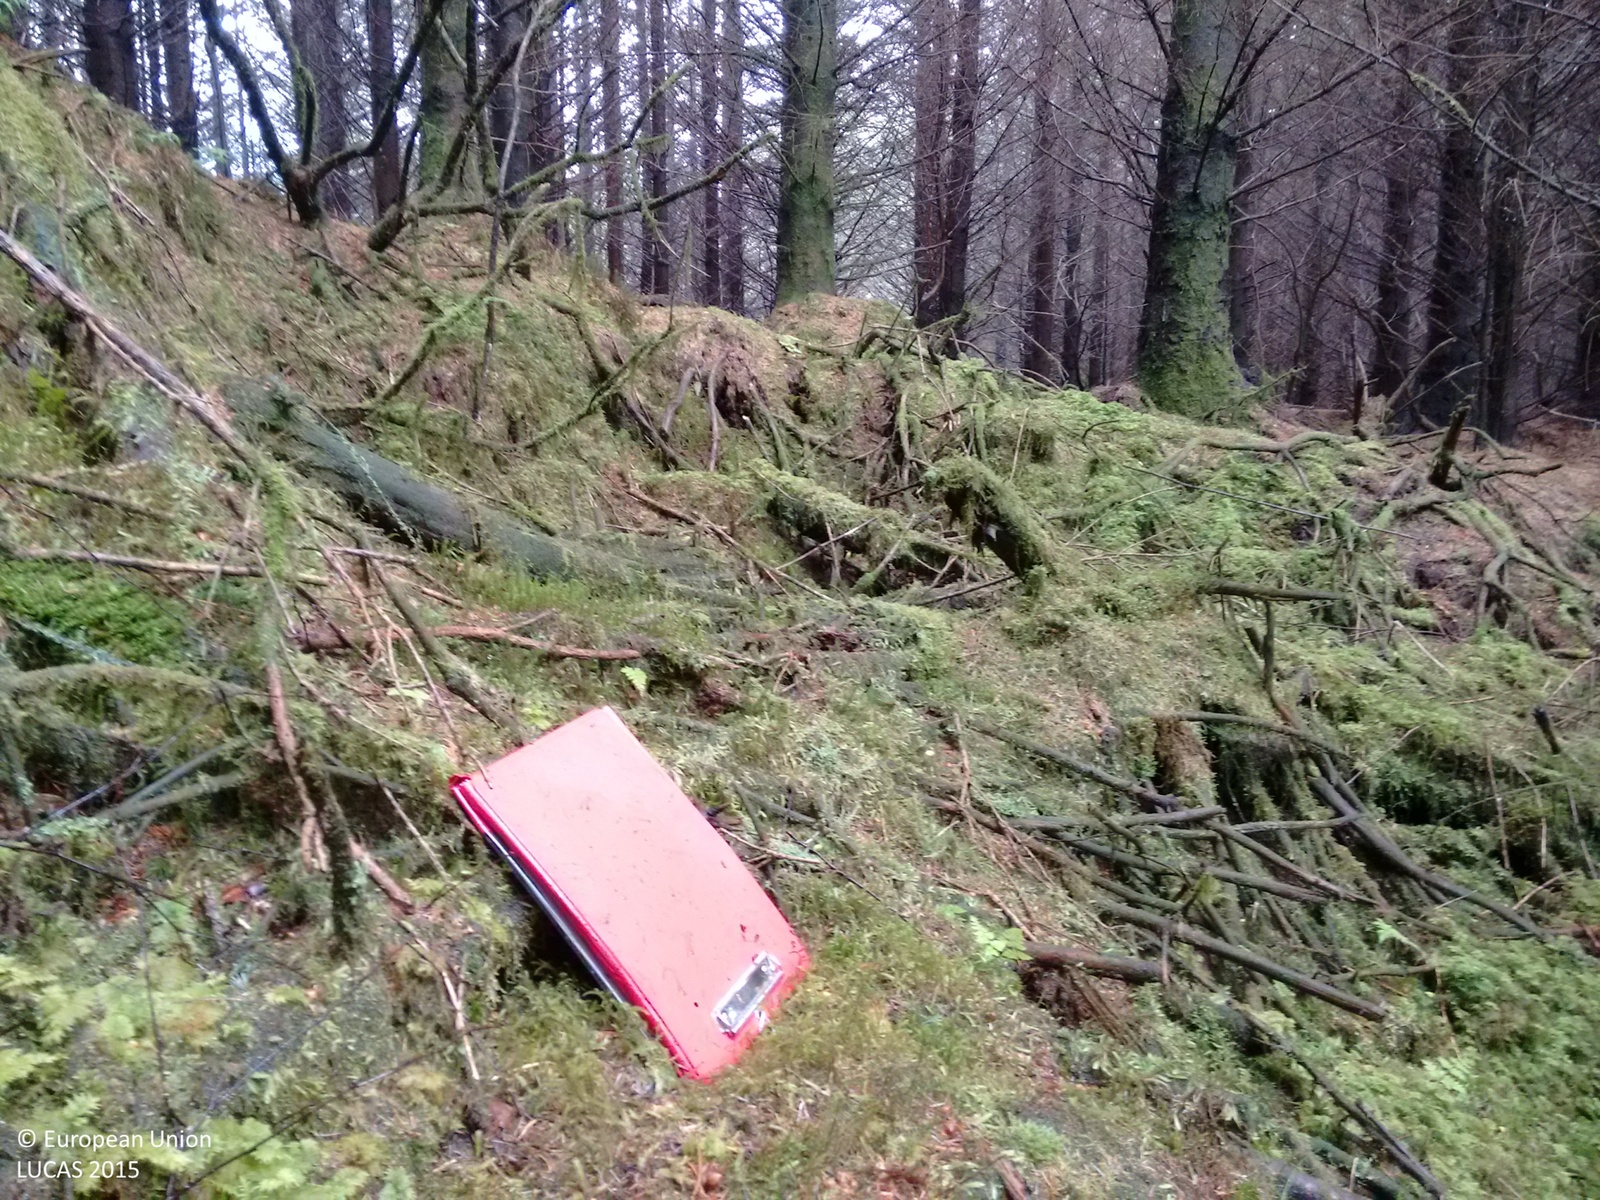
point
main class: Woodland
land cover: Spruce dominated coniferous woodland
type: exotic forest
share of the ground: > 75 %
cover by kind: coniferous forest trees 100 %
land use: Forestry
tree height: > 5 m
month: June
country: GB
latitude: 56.0369
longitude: -5.4157
